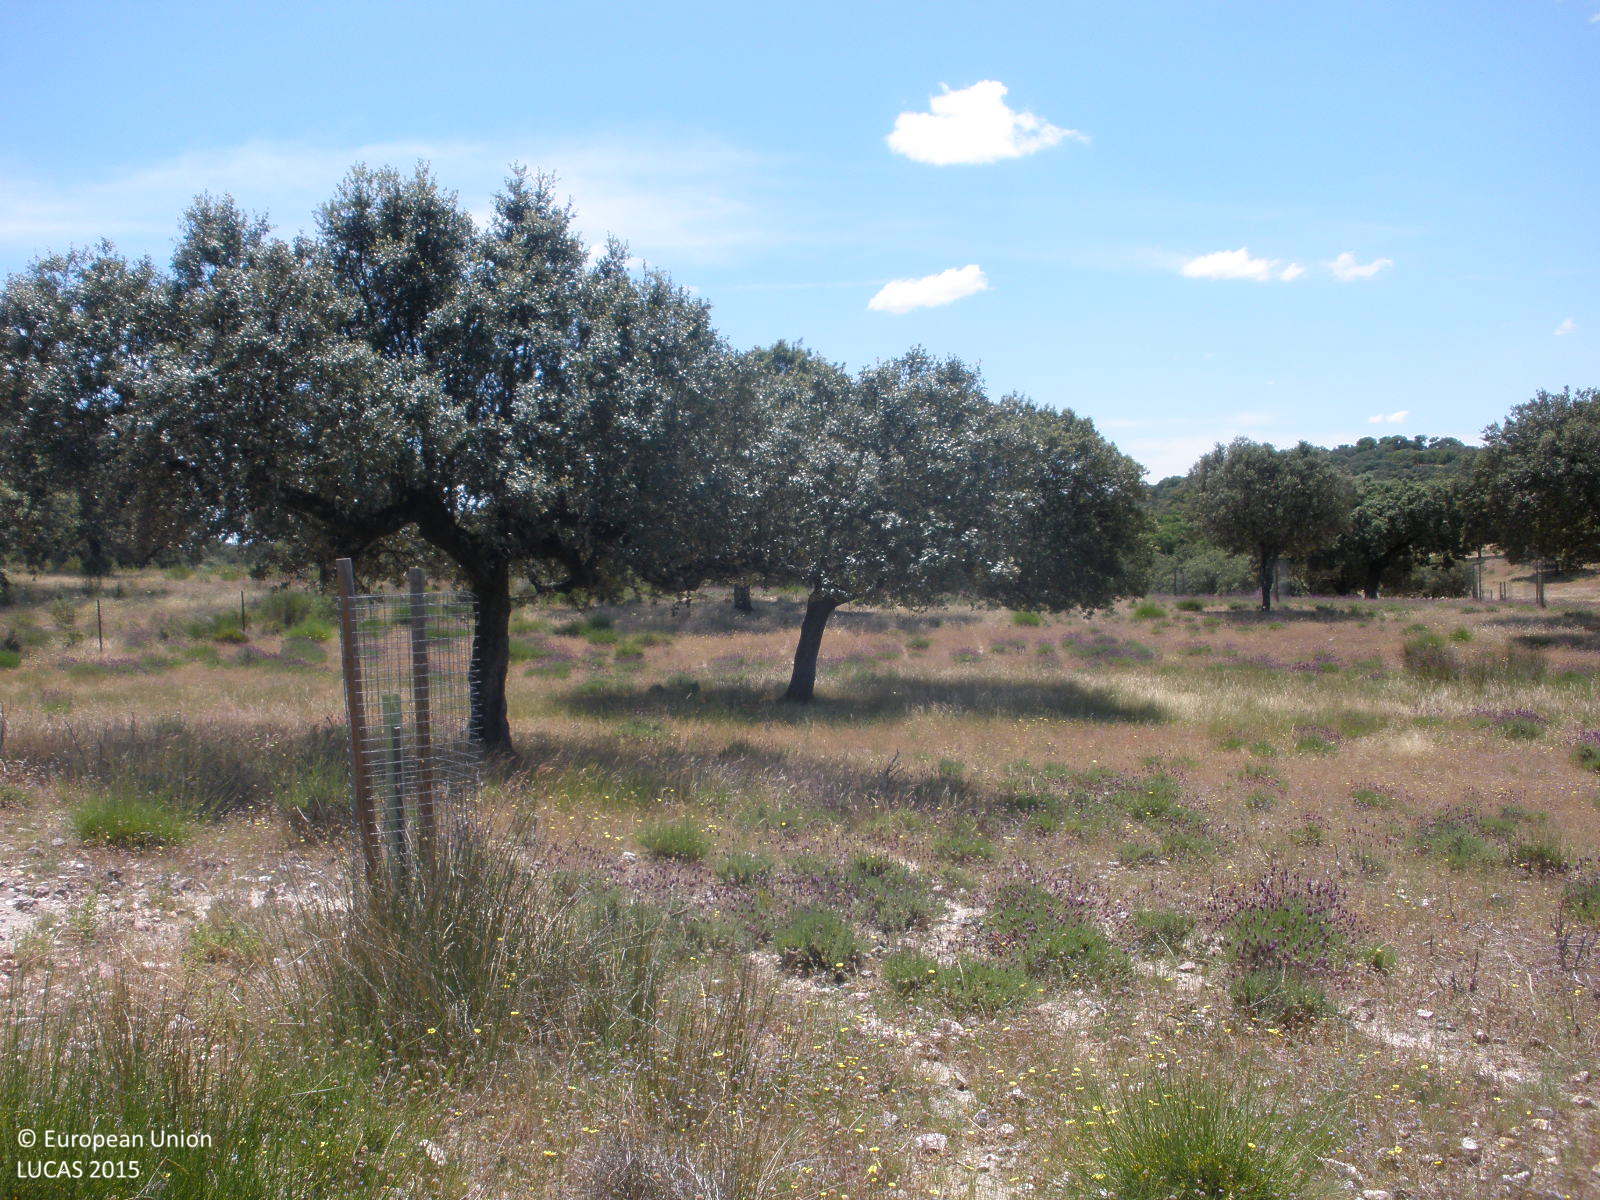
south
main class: Woodland
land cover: Broadleaved woodland
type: broadleaved evergreen forest
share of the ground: 10 - 25 %
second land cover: Grassland without tree/shrub cover
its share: > 75 %
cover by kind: herbaceous plants 70 %, broadleaved forest trees 10 %, shrubs 10 %, consolidated bare surface 10 %
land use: Forestry
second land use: Agriculture (excluding fallow land and kitchen gardens)
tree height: > 5 m
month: May
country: ES
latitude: 40.2391
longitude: -6.0721
